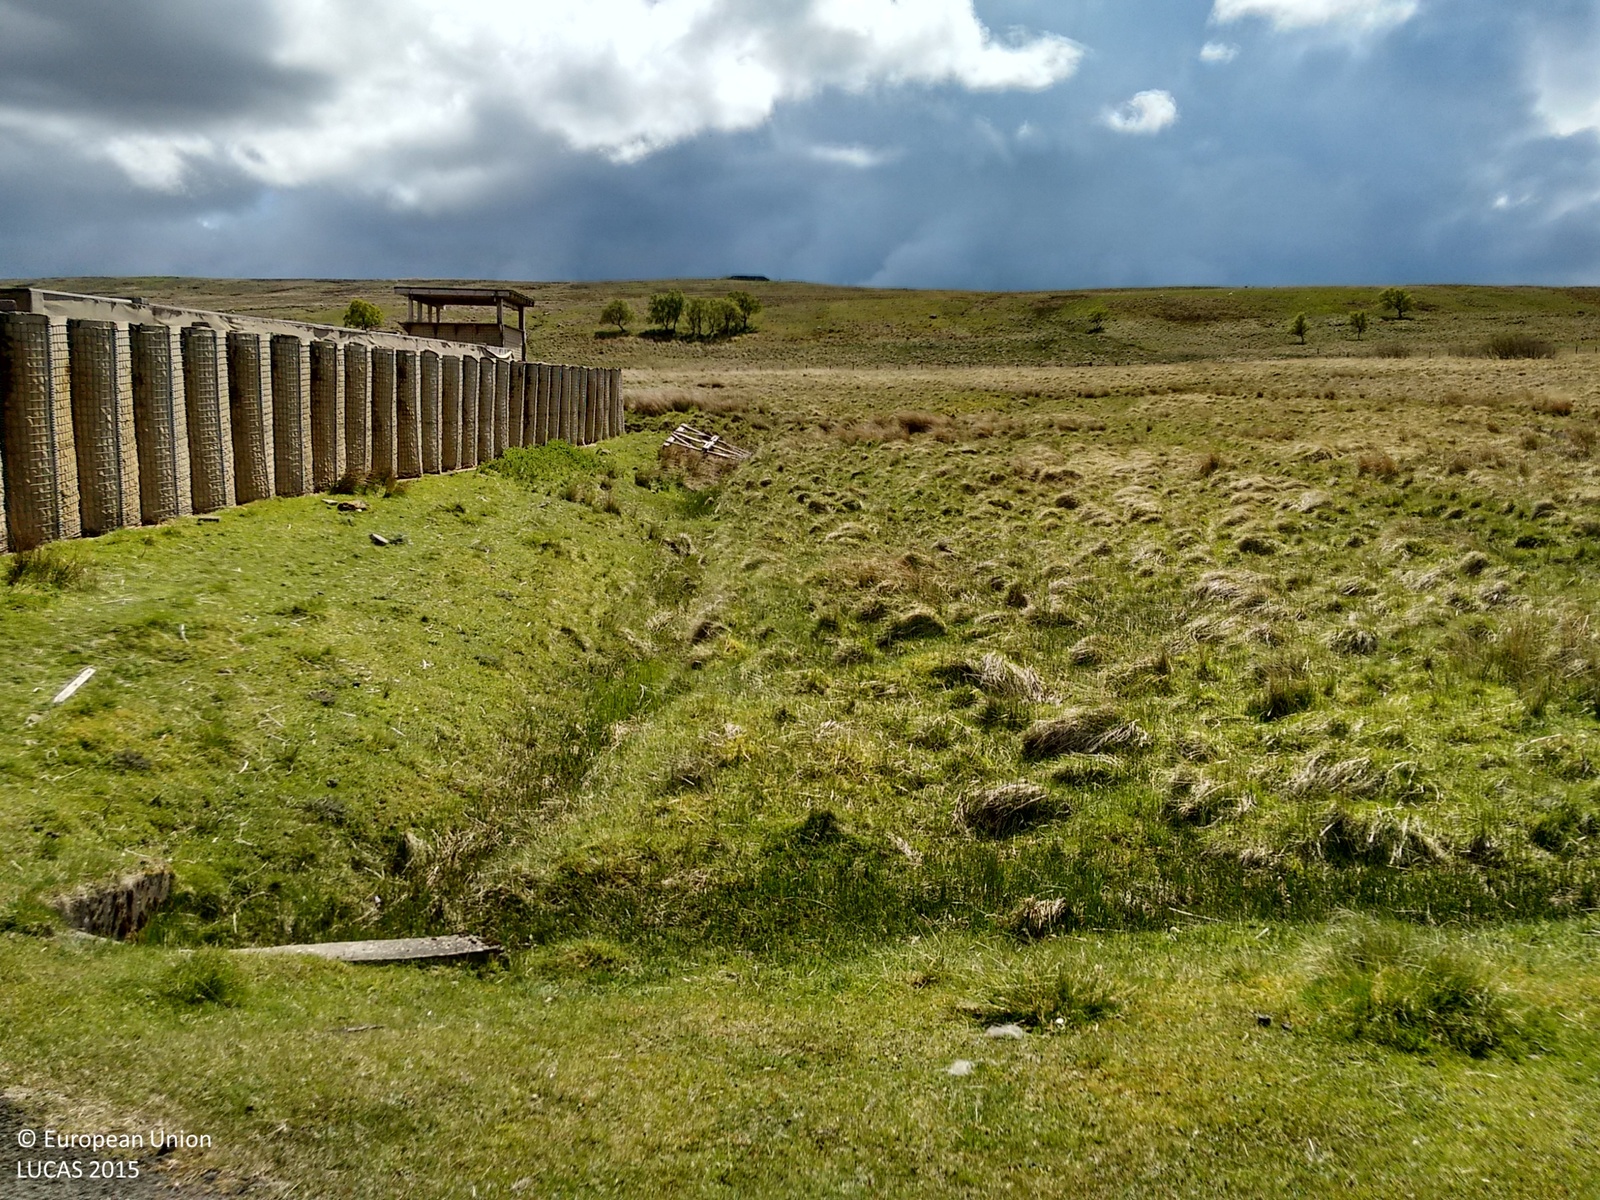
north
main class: Shrubland
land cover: Shrubland without tree cover
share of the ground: > 75 %
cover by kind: shrubs 80 %, herbaceous plants 20 %
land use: Agriculture (excluding fallow land and kitchen gardens)
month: May
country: GB
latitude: 55.3143
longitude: -2.1731
